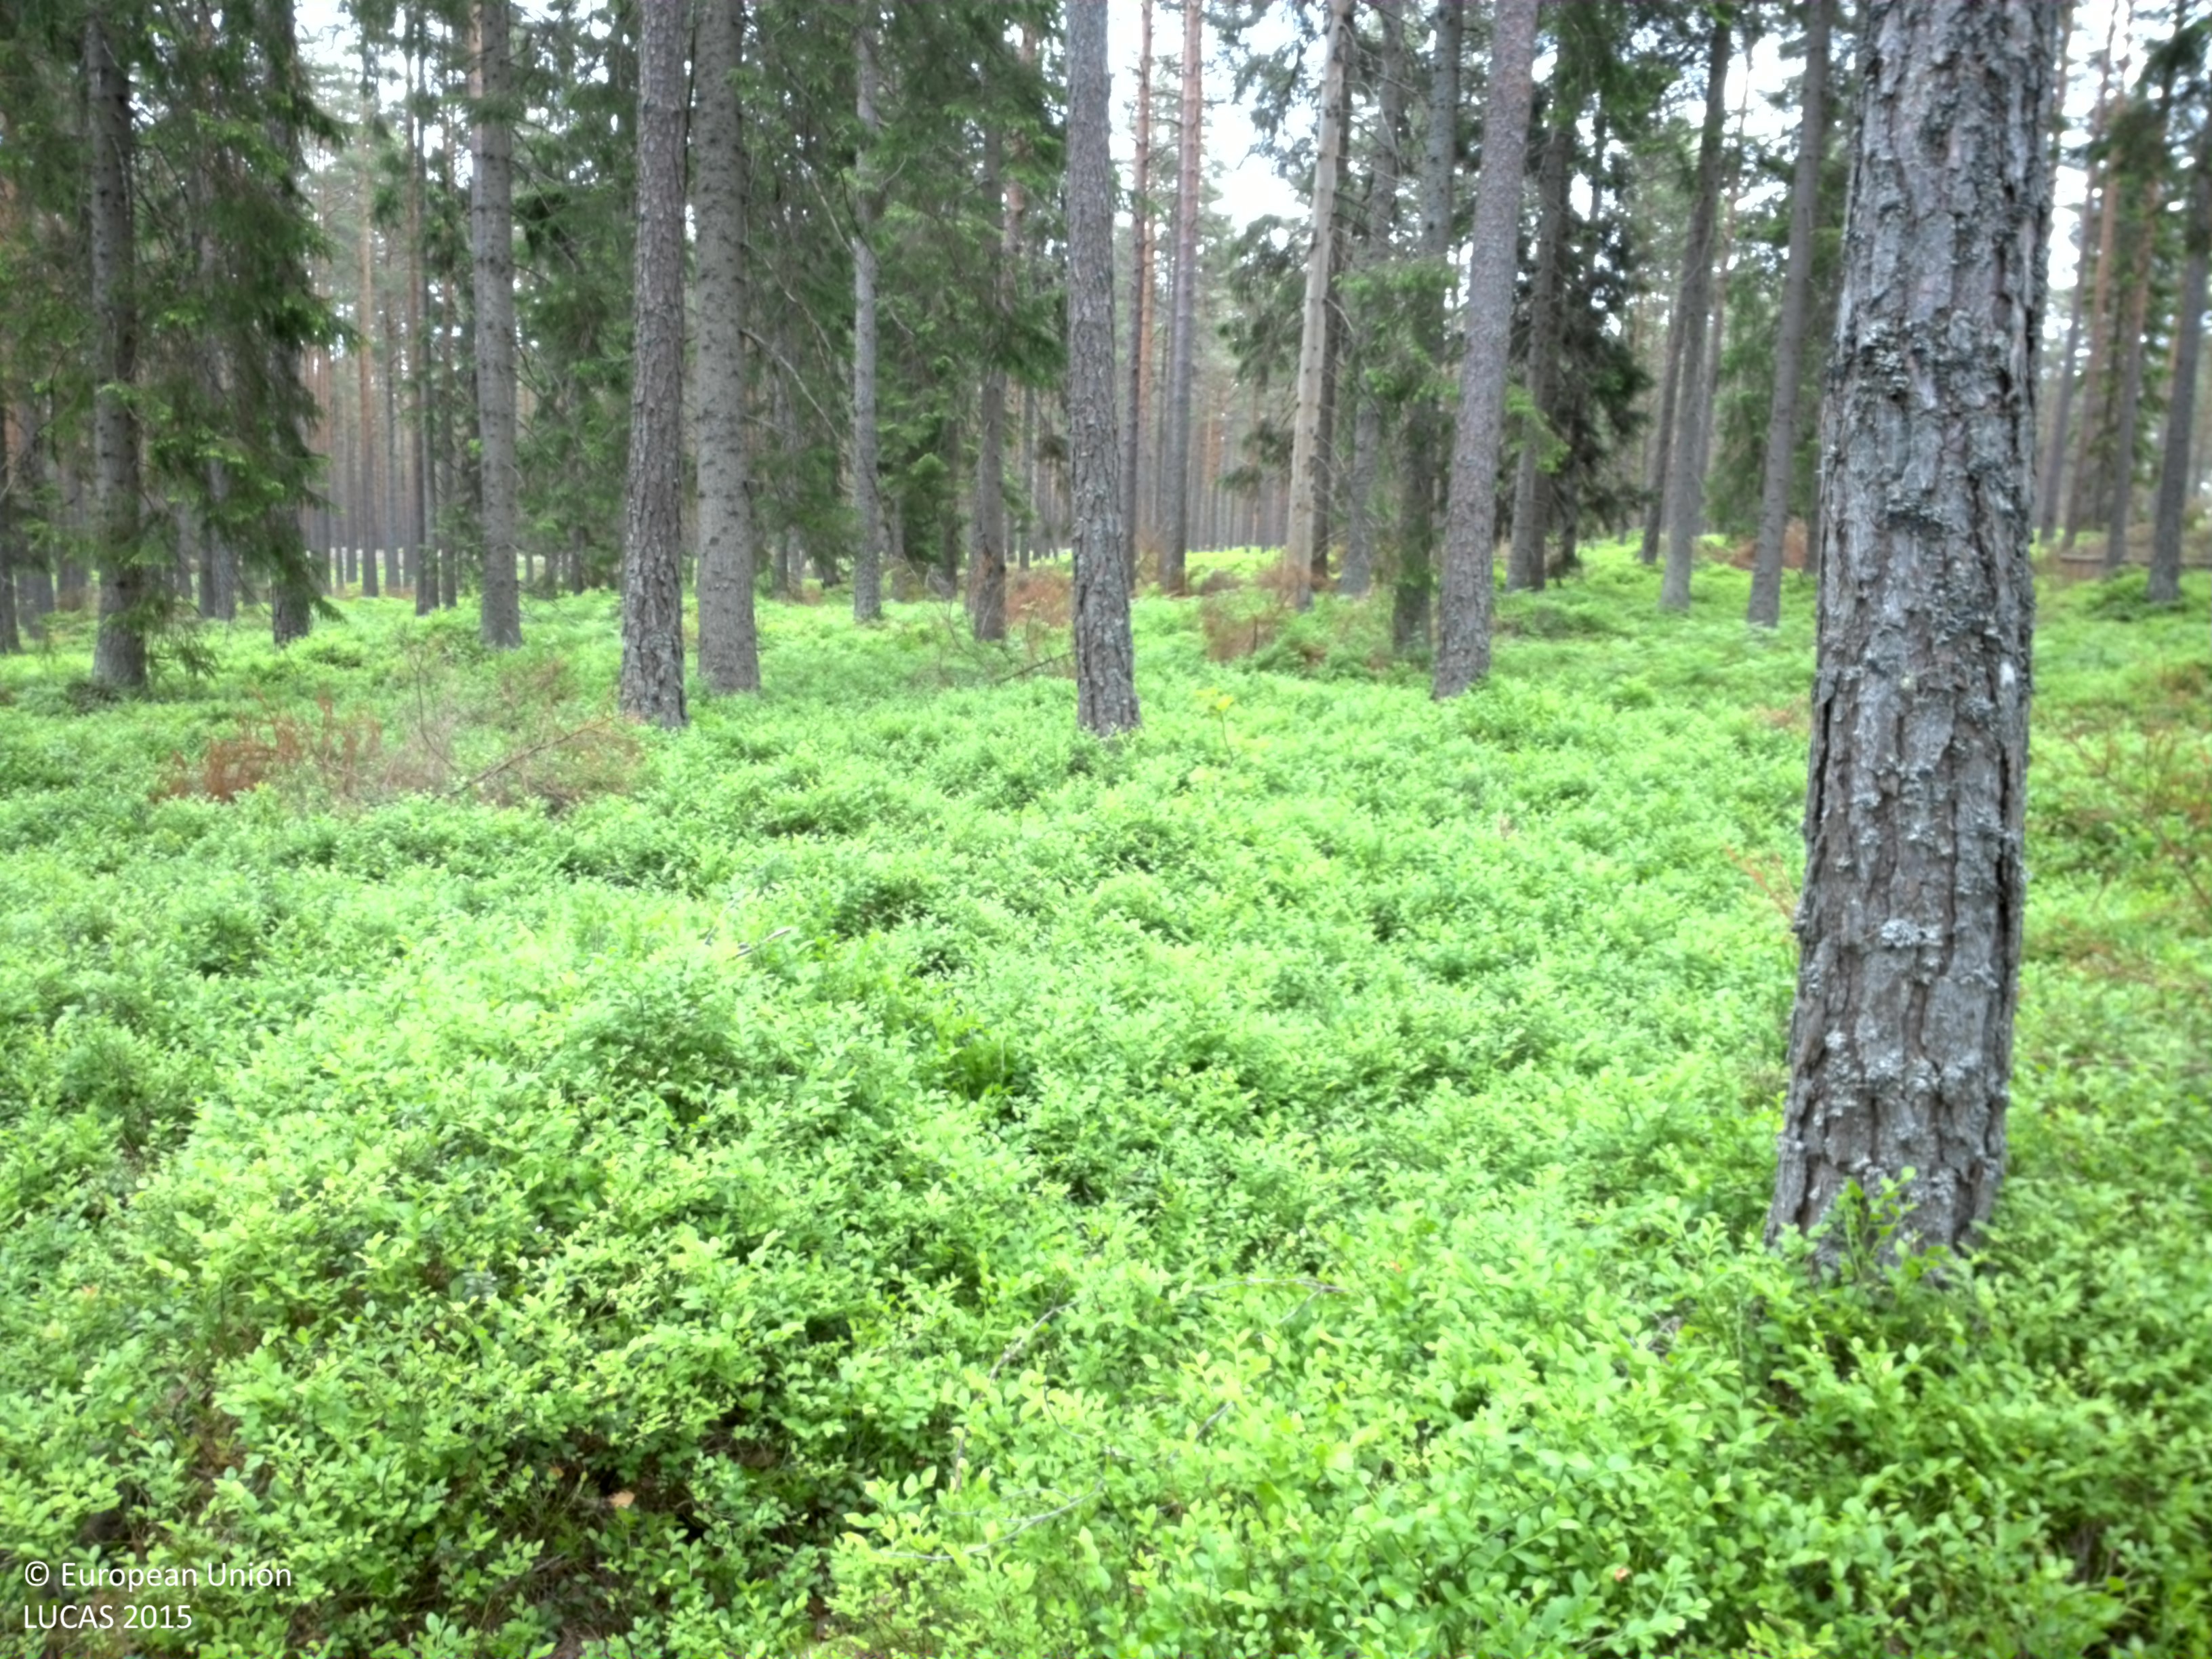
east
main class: Woodland
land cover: Pine dominated coniferous woodland
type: boreal forest
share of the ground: 10 - 25 %
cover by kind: shrubs 60 %, coniferous forest trees 20 %, lichens and mosses 15 %, herbaceous plants 5 %
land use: Forestry
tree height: > 5 m
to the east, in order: Pine dominated coniferous woodland; Tracks; Pine dominated coniferous woodland
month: June
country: SE
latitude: 58.7088
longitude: 16.5723
